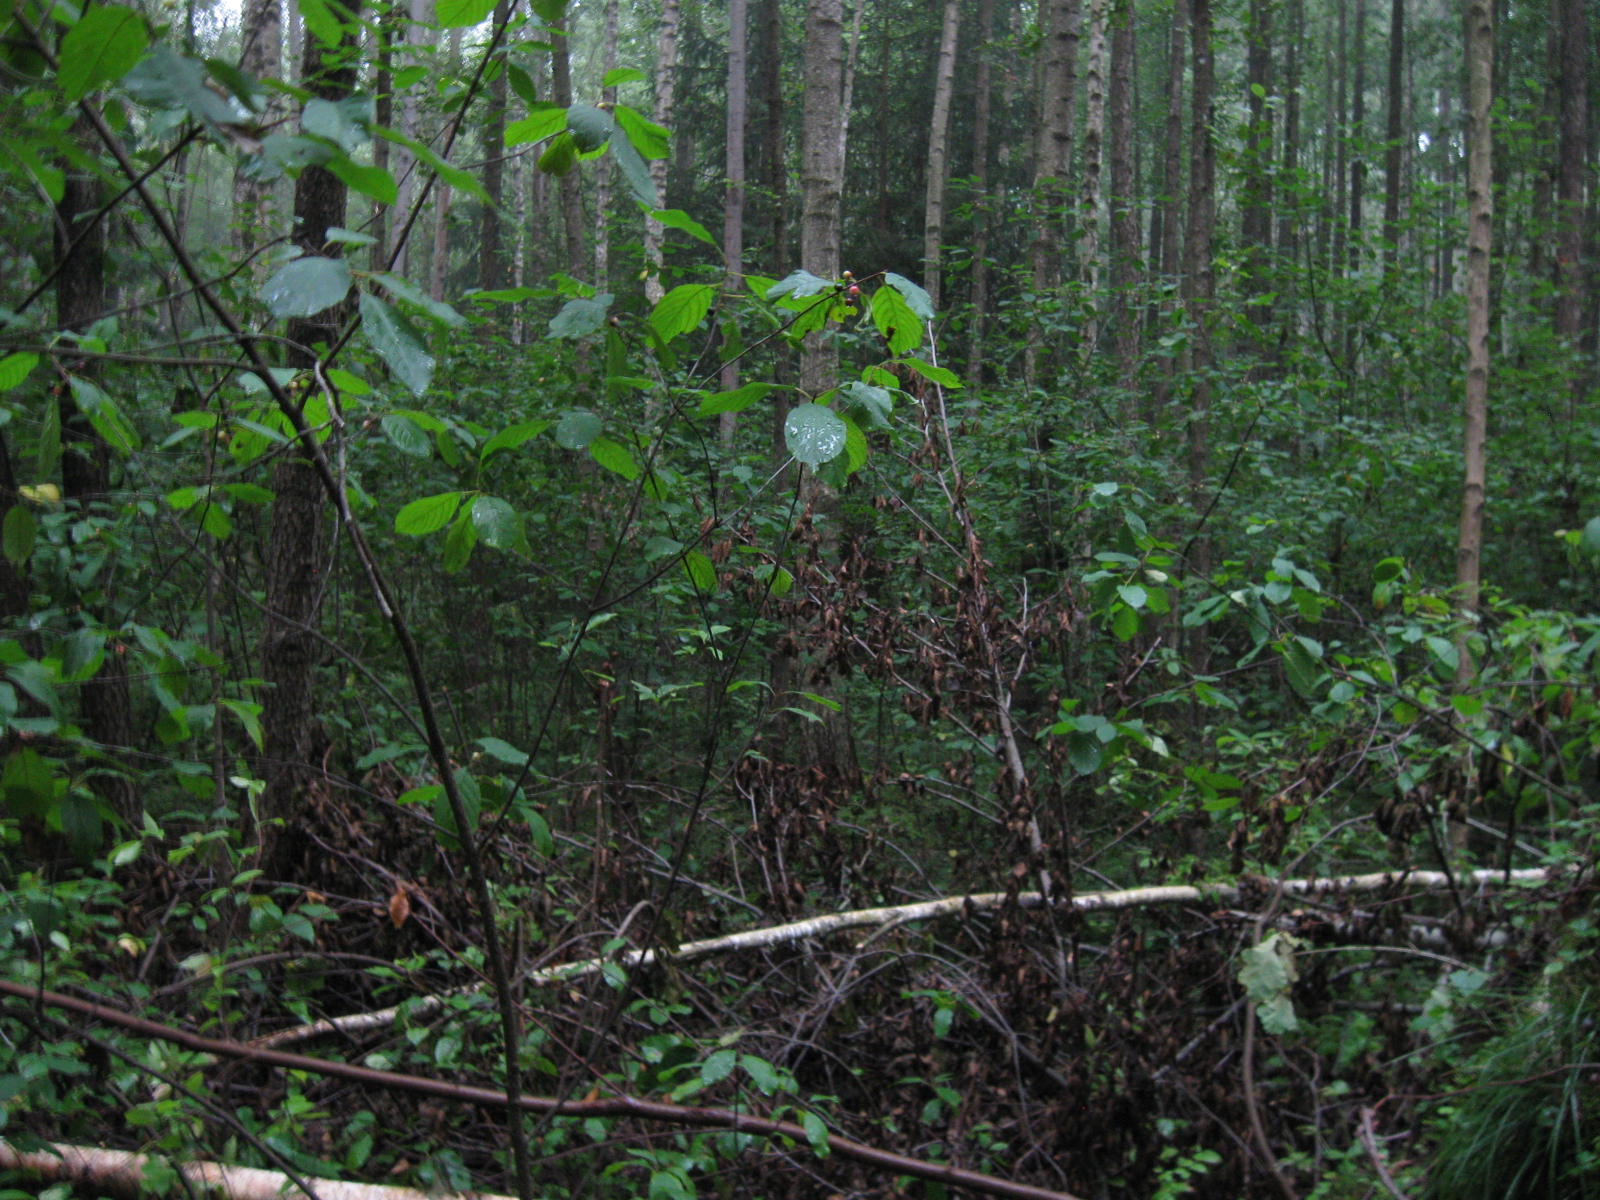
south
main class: Woodland
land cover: Broadleaved woodland
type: non-riverine alder, birch or aspen forest
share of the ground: > 75 %
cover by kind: broadleaved forest trees 85 %, coniferous forest trees 5 %, shrubs 5 %, herbaceous plants 5 %
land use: Forestry
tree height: > 5 m
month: August
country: LT
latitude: 54.7454
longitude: 23.6143
